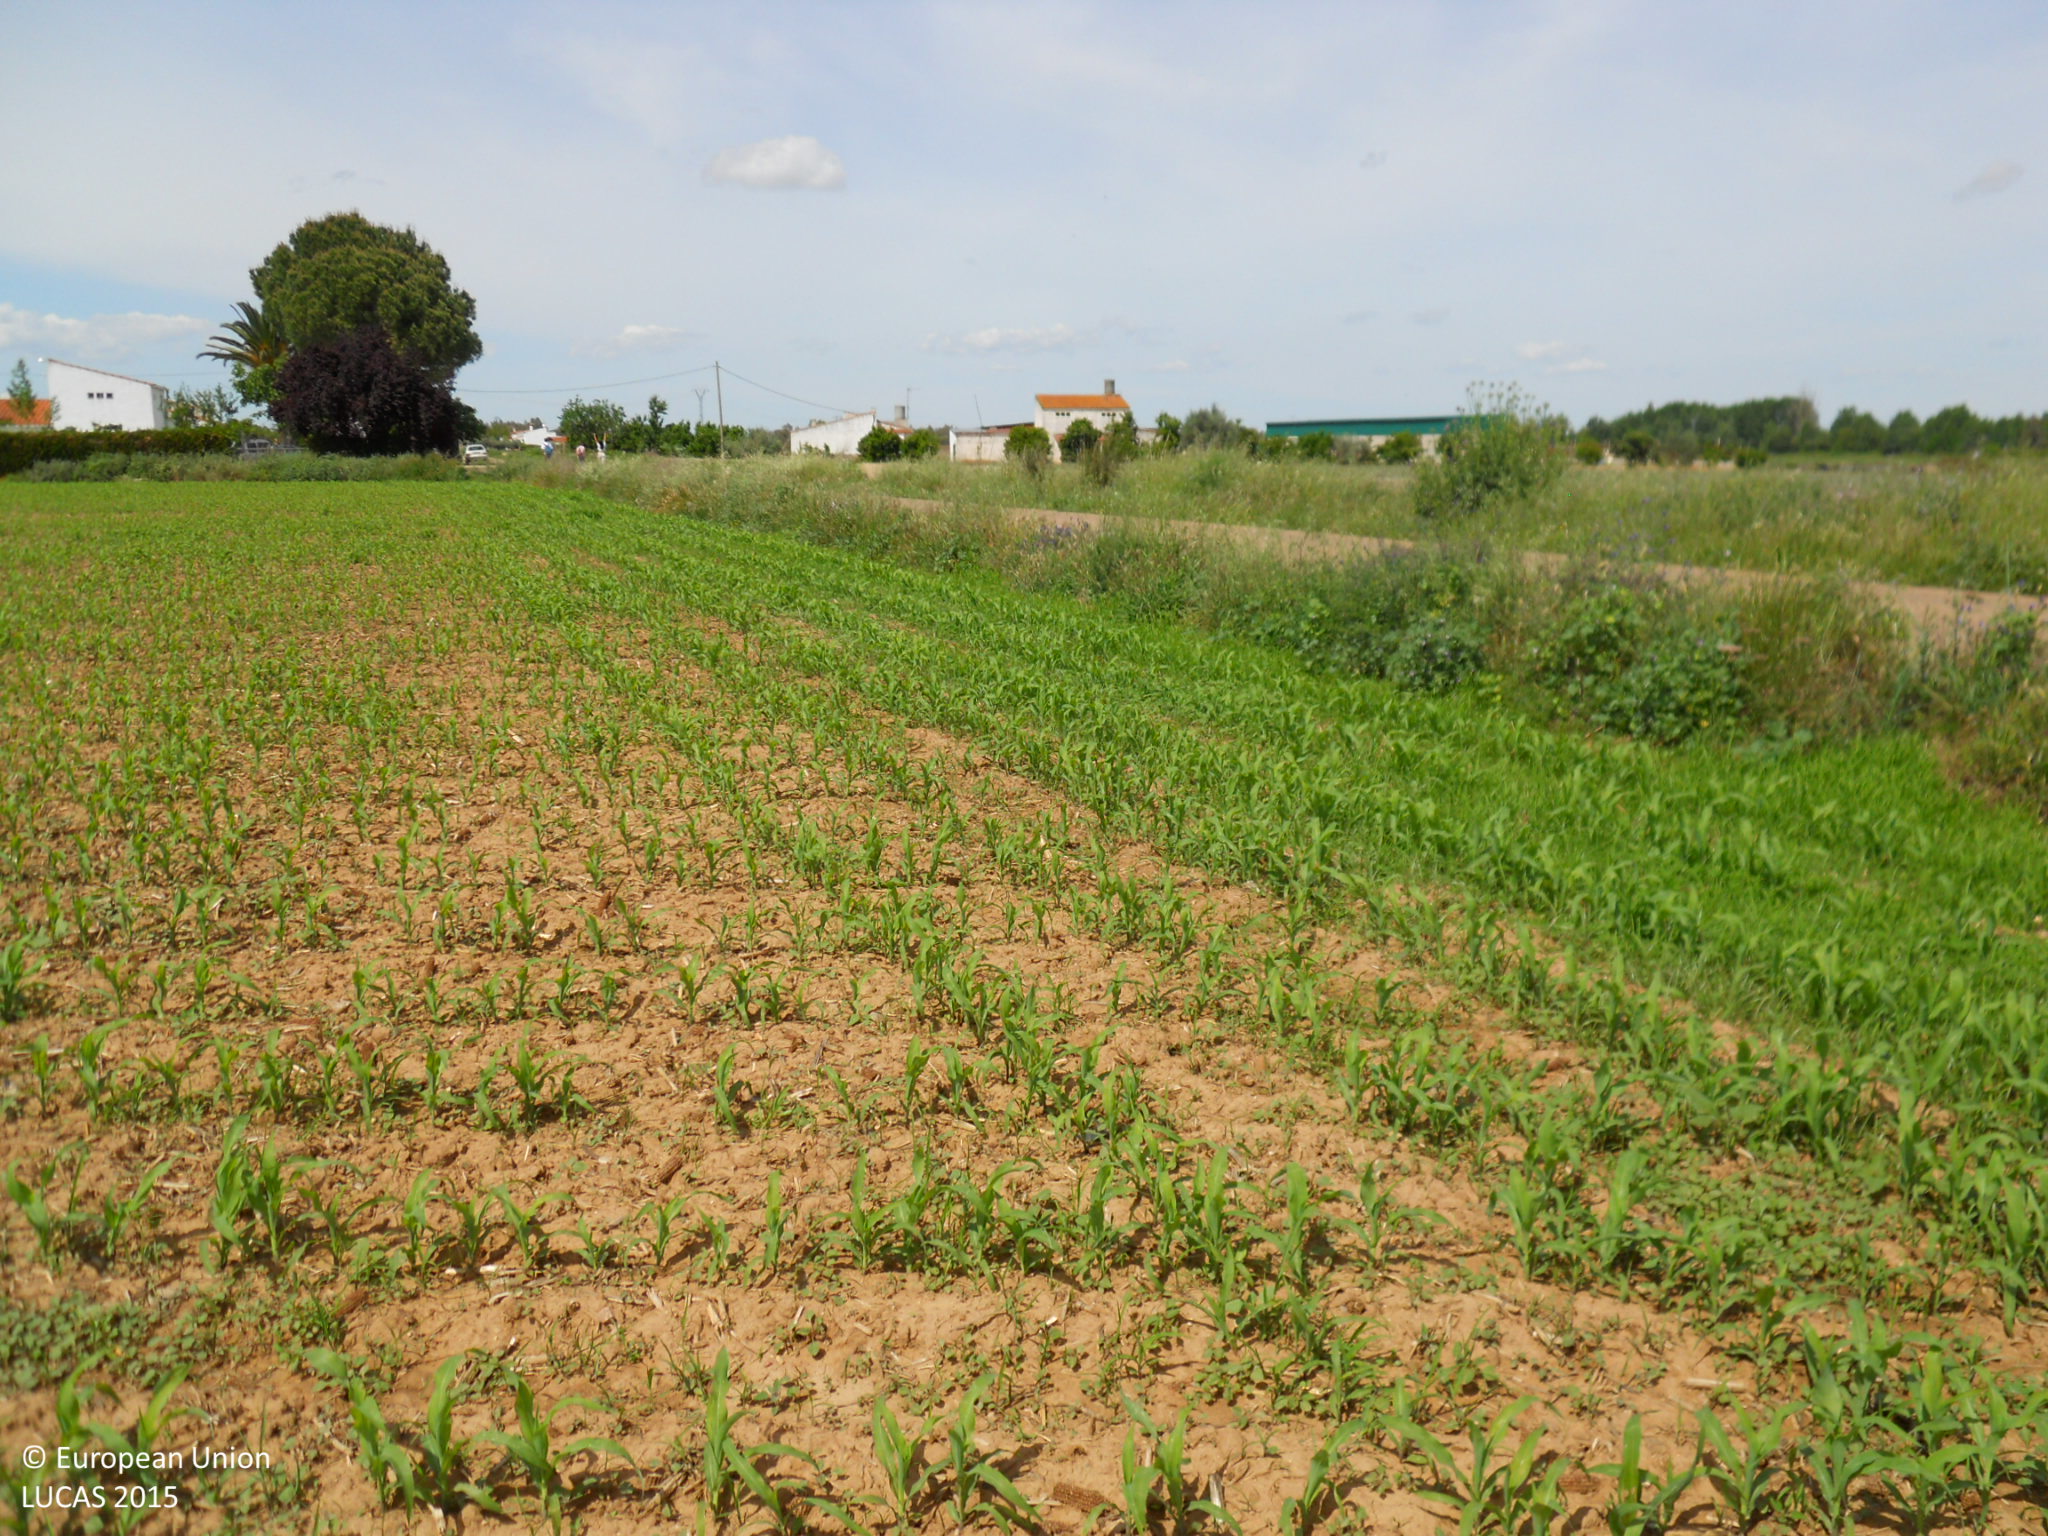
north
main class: Cropland
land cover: Maize
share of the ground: 10 - 25 %
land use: Agriculture (excluding fallow land and kitchen gardens)
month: April
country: ES
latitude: 38.9678
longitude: -6.9327
